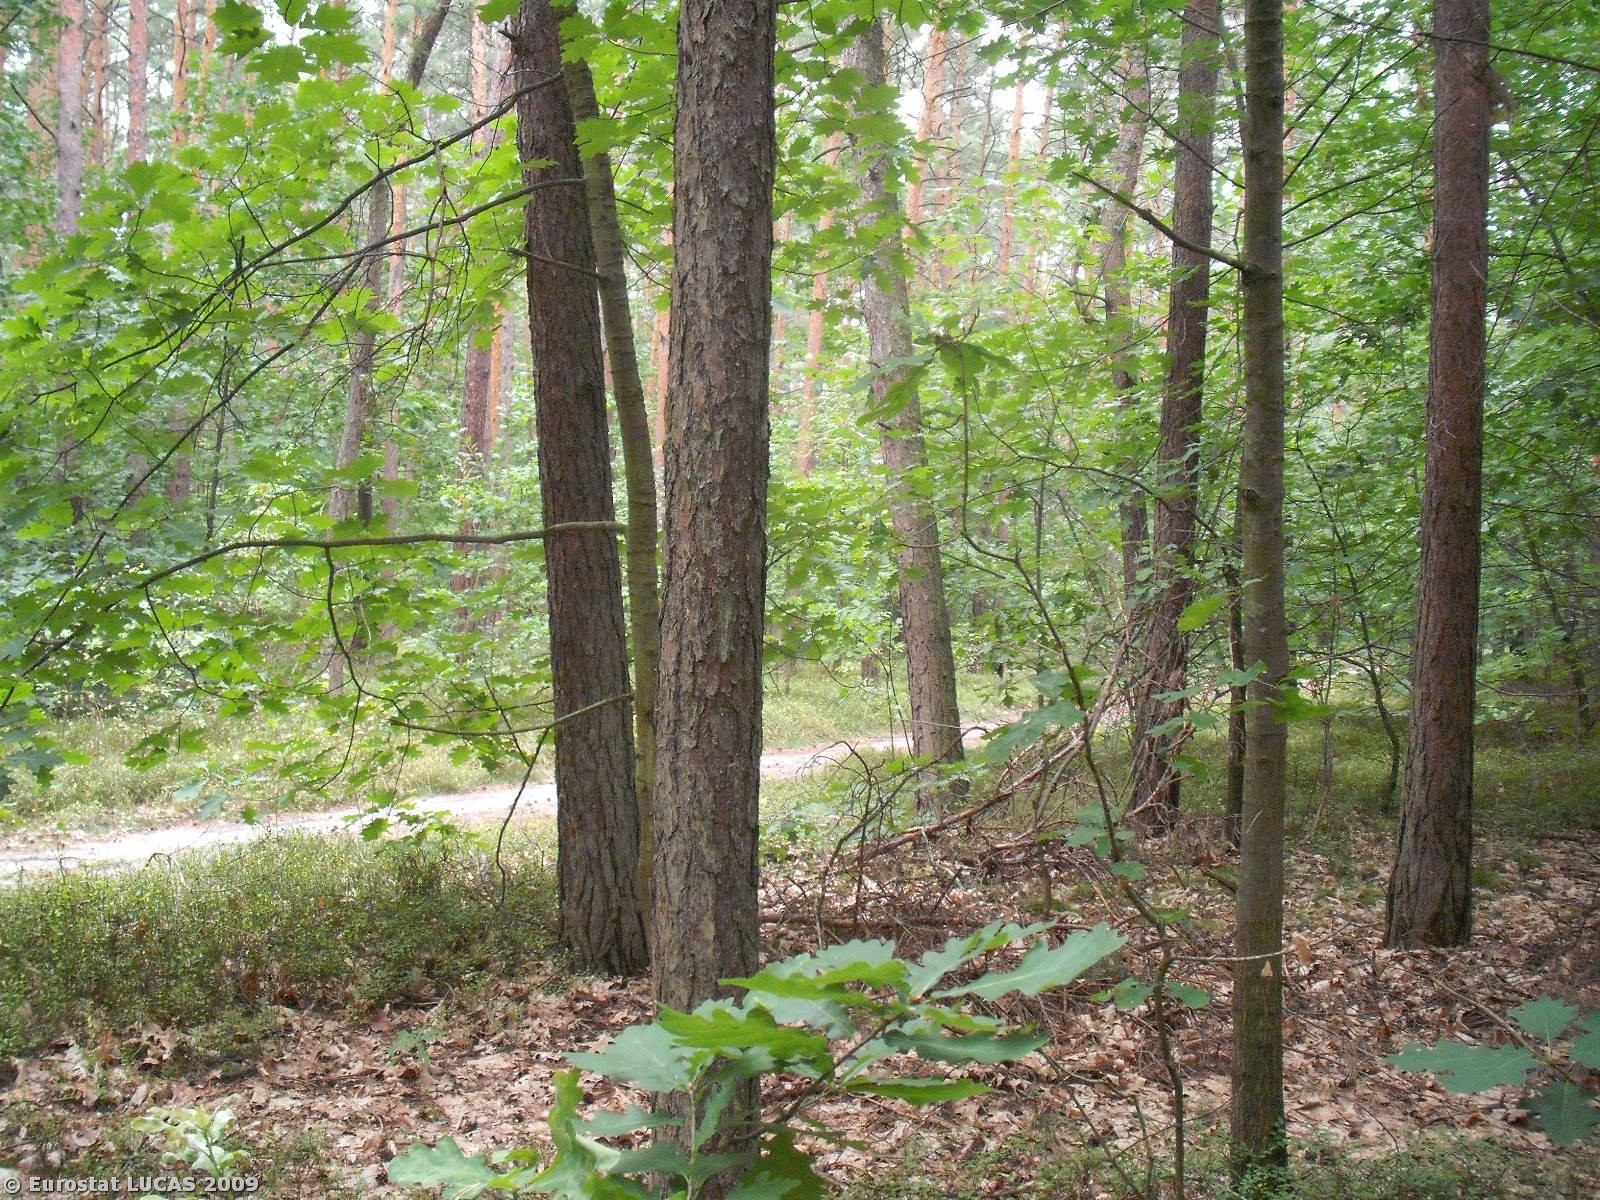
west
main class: Woodland
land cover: Mixed woodland
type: hemiboreal forest and nemoral coniferous forest and mixed broadleaved-coniferous forest
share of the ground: > 75 %
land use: Forestry
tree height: > 5 m
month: August
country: PL
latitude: 51.9565
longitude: 21.1788
